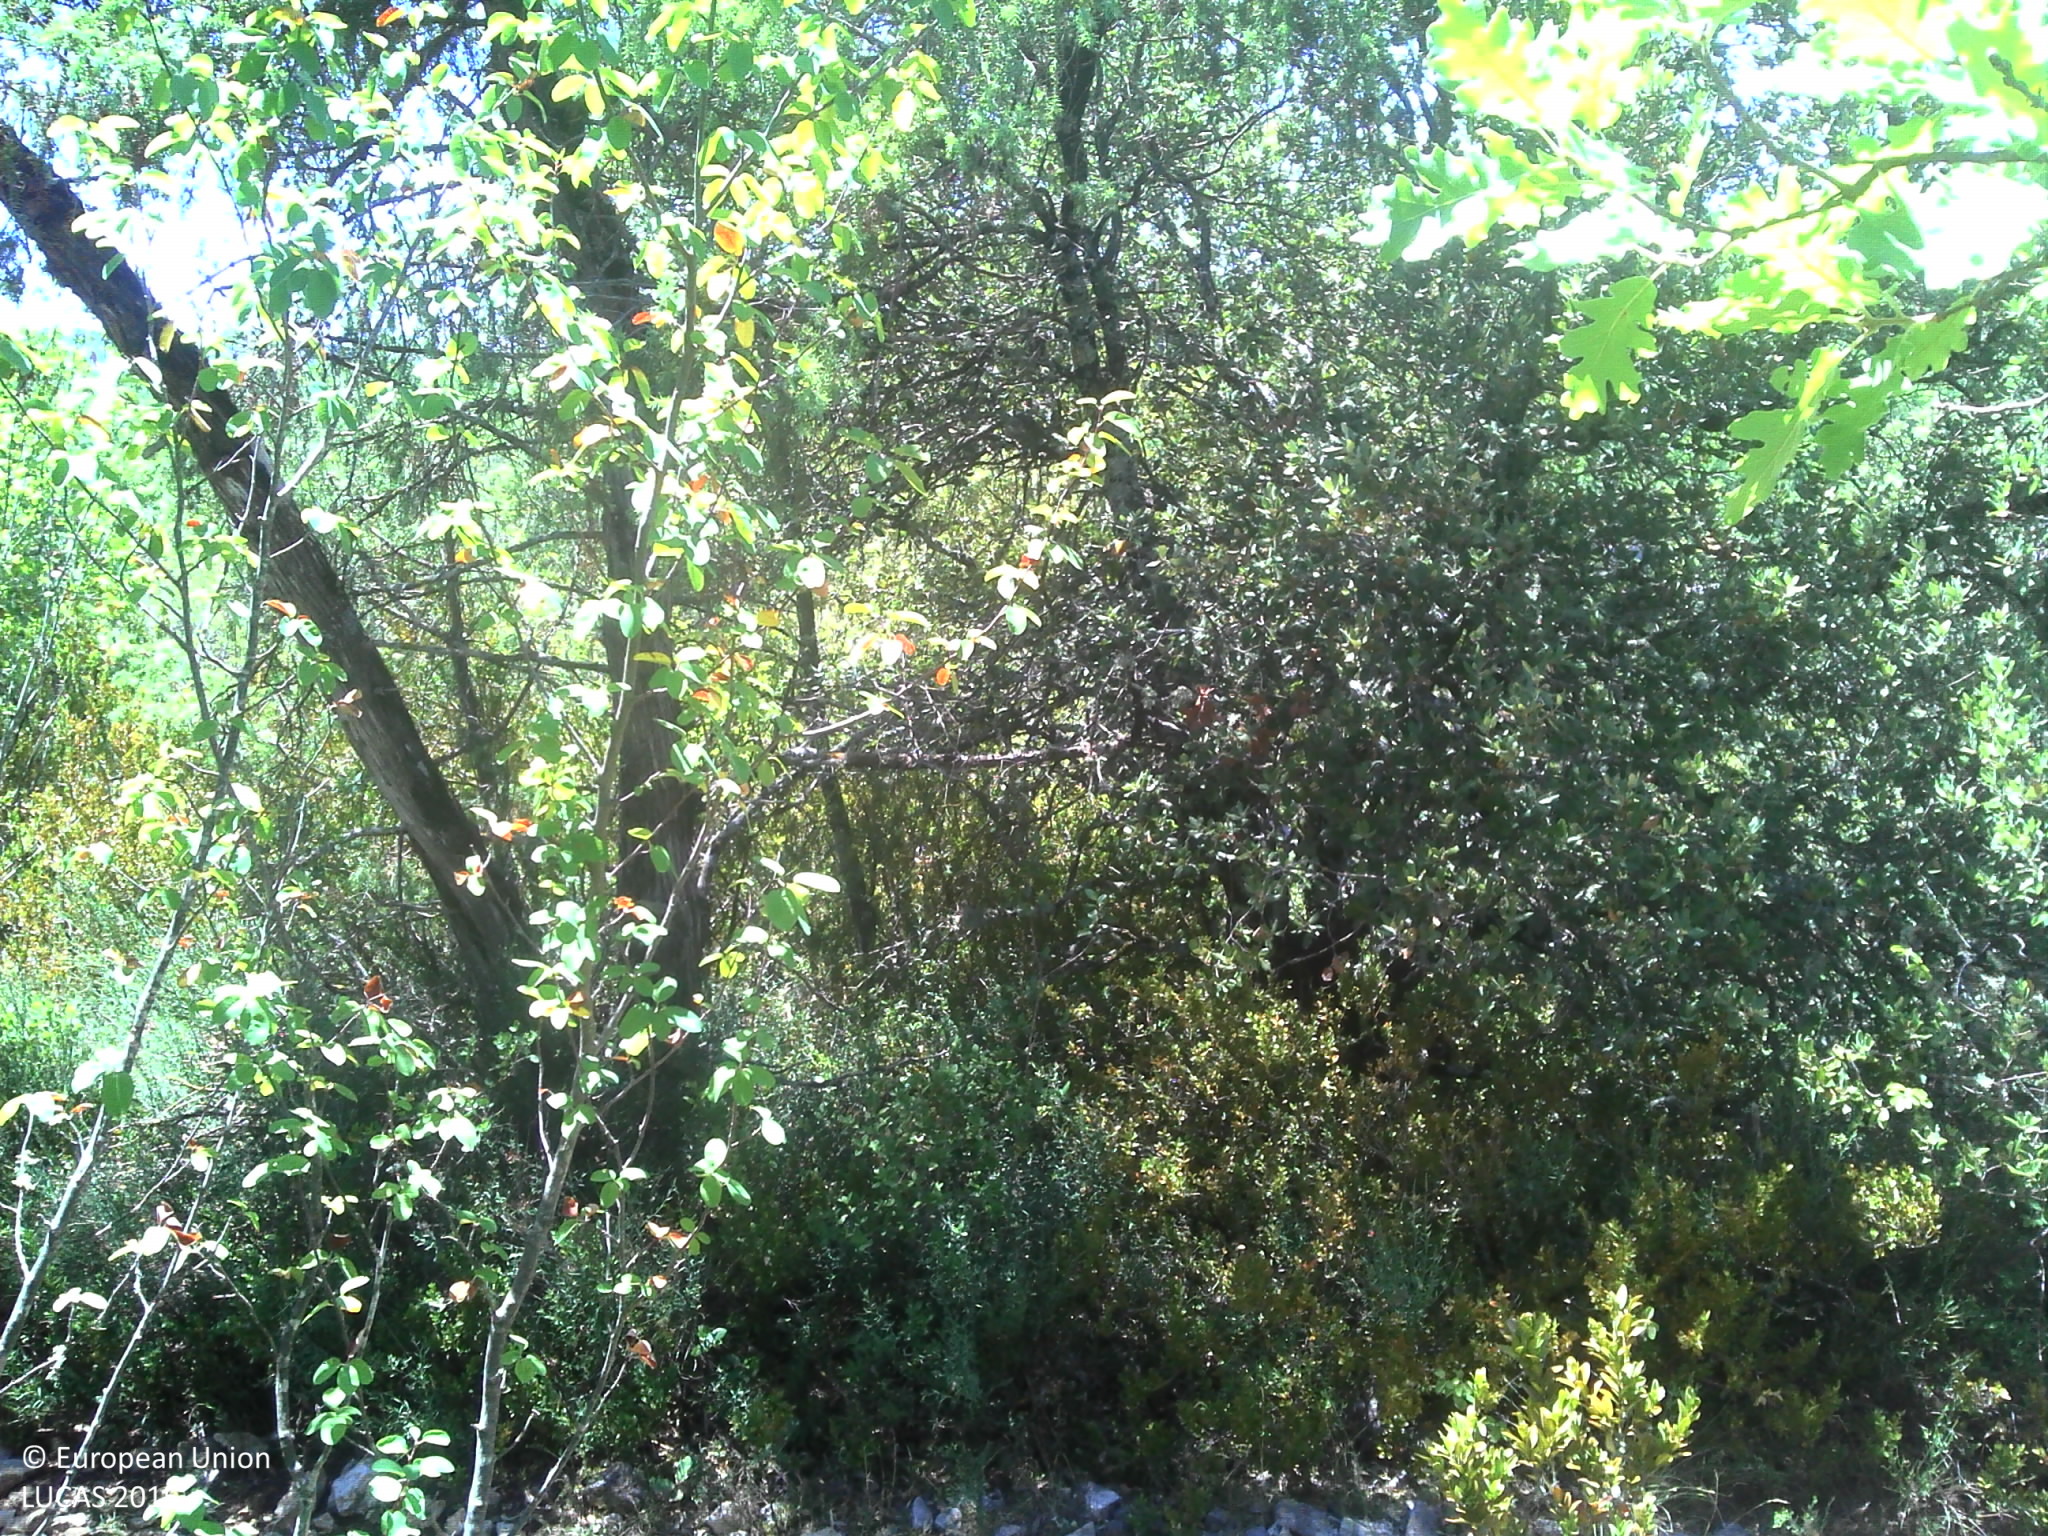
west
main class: Woodland
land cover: Broadleaved woodland
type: thermophilous deciduous forest
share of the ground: 50 - 75 %
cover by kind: broadleaved forest trees 75 %, shrubs 25 %
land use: Forestry
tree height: > 5 m
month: July
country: FR
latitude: 43.9316
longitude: 5.5864
